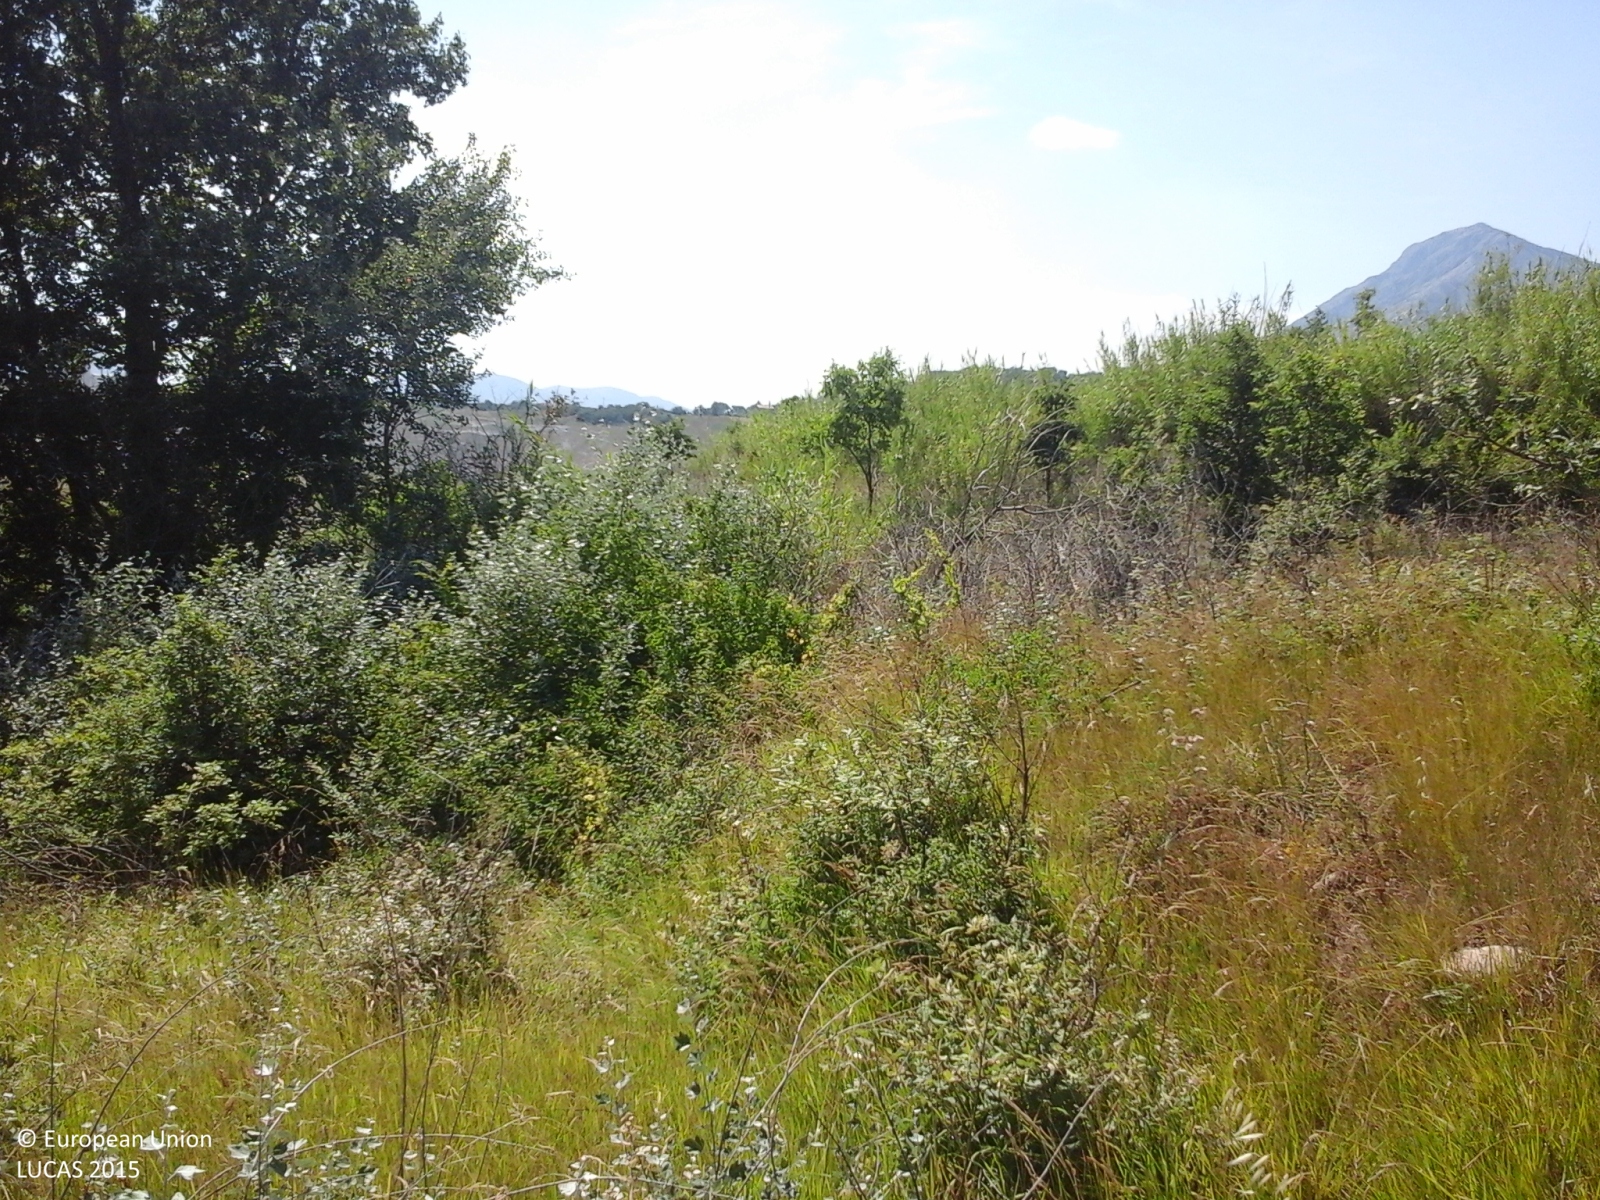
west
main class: Shrubland
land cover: Shrubland with sparse tree cover
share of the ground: > 75 %
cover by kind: herbaceous plants 60 %, shrubs 35 %, broadleaved forest trees 5 %
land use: Abandoned areas
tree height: > 5 m
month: July
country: IT
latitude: 41.0616
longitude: 14.6822
